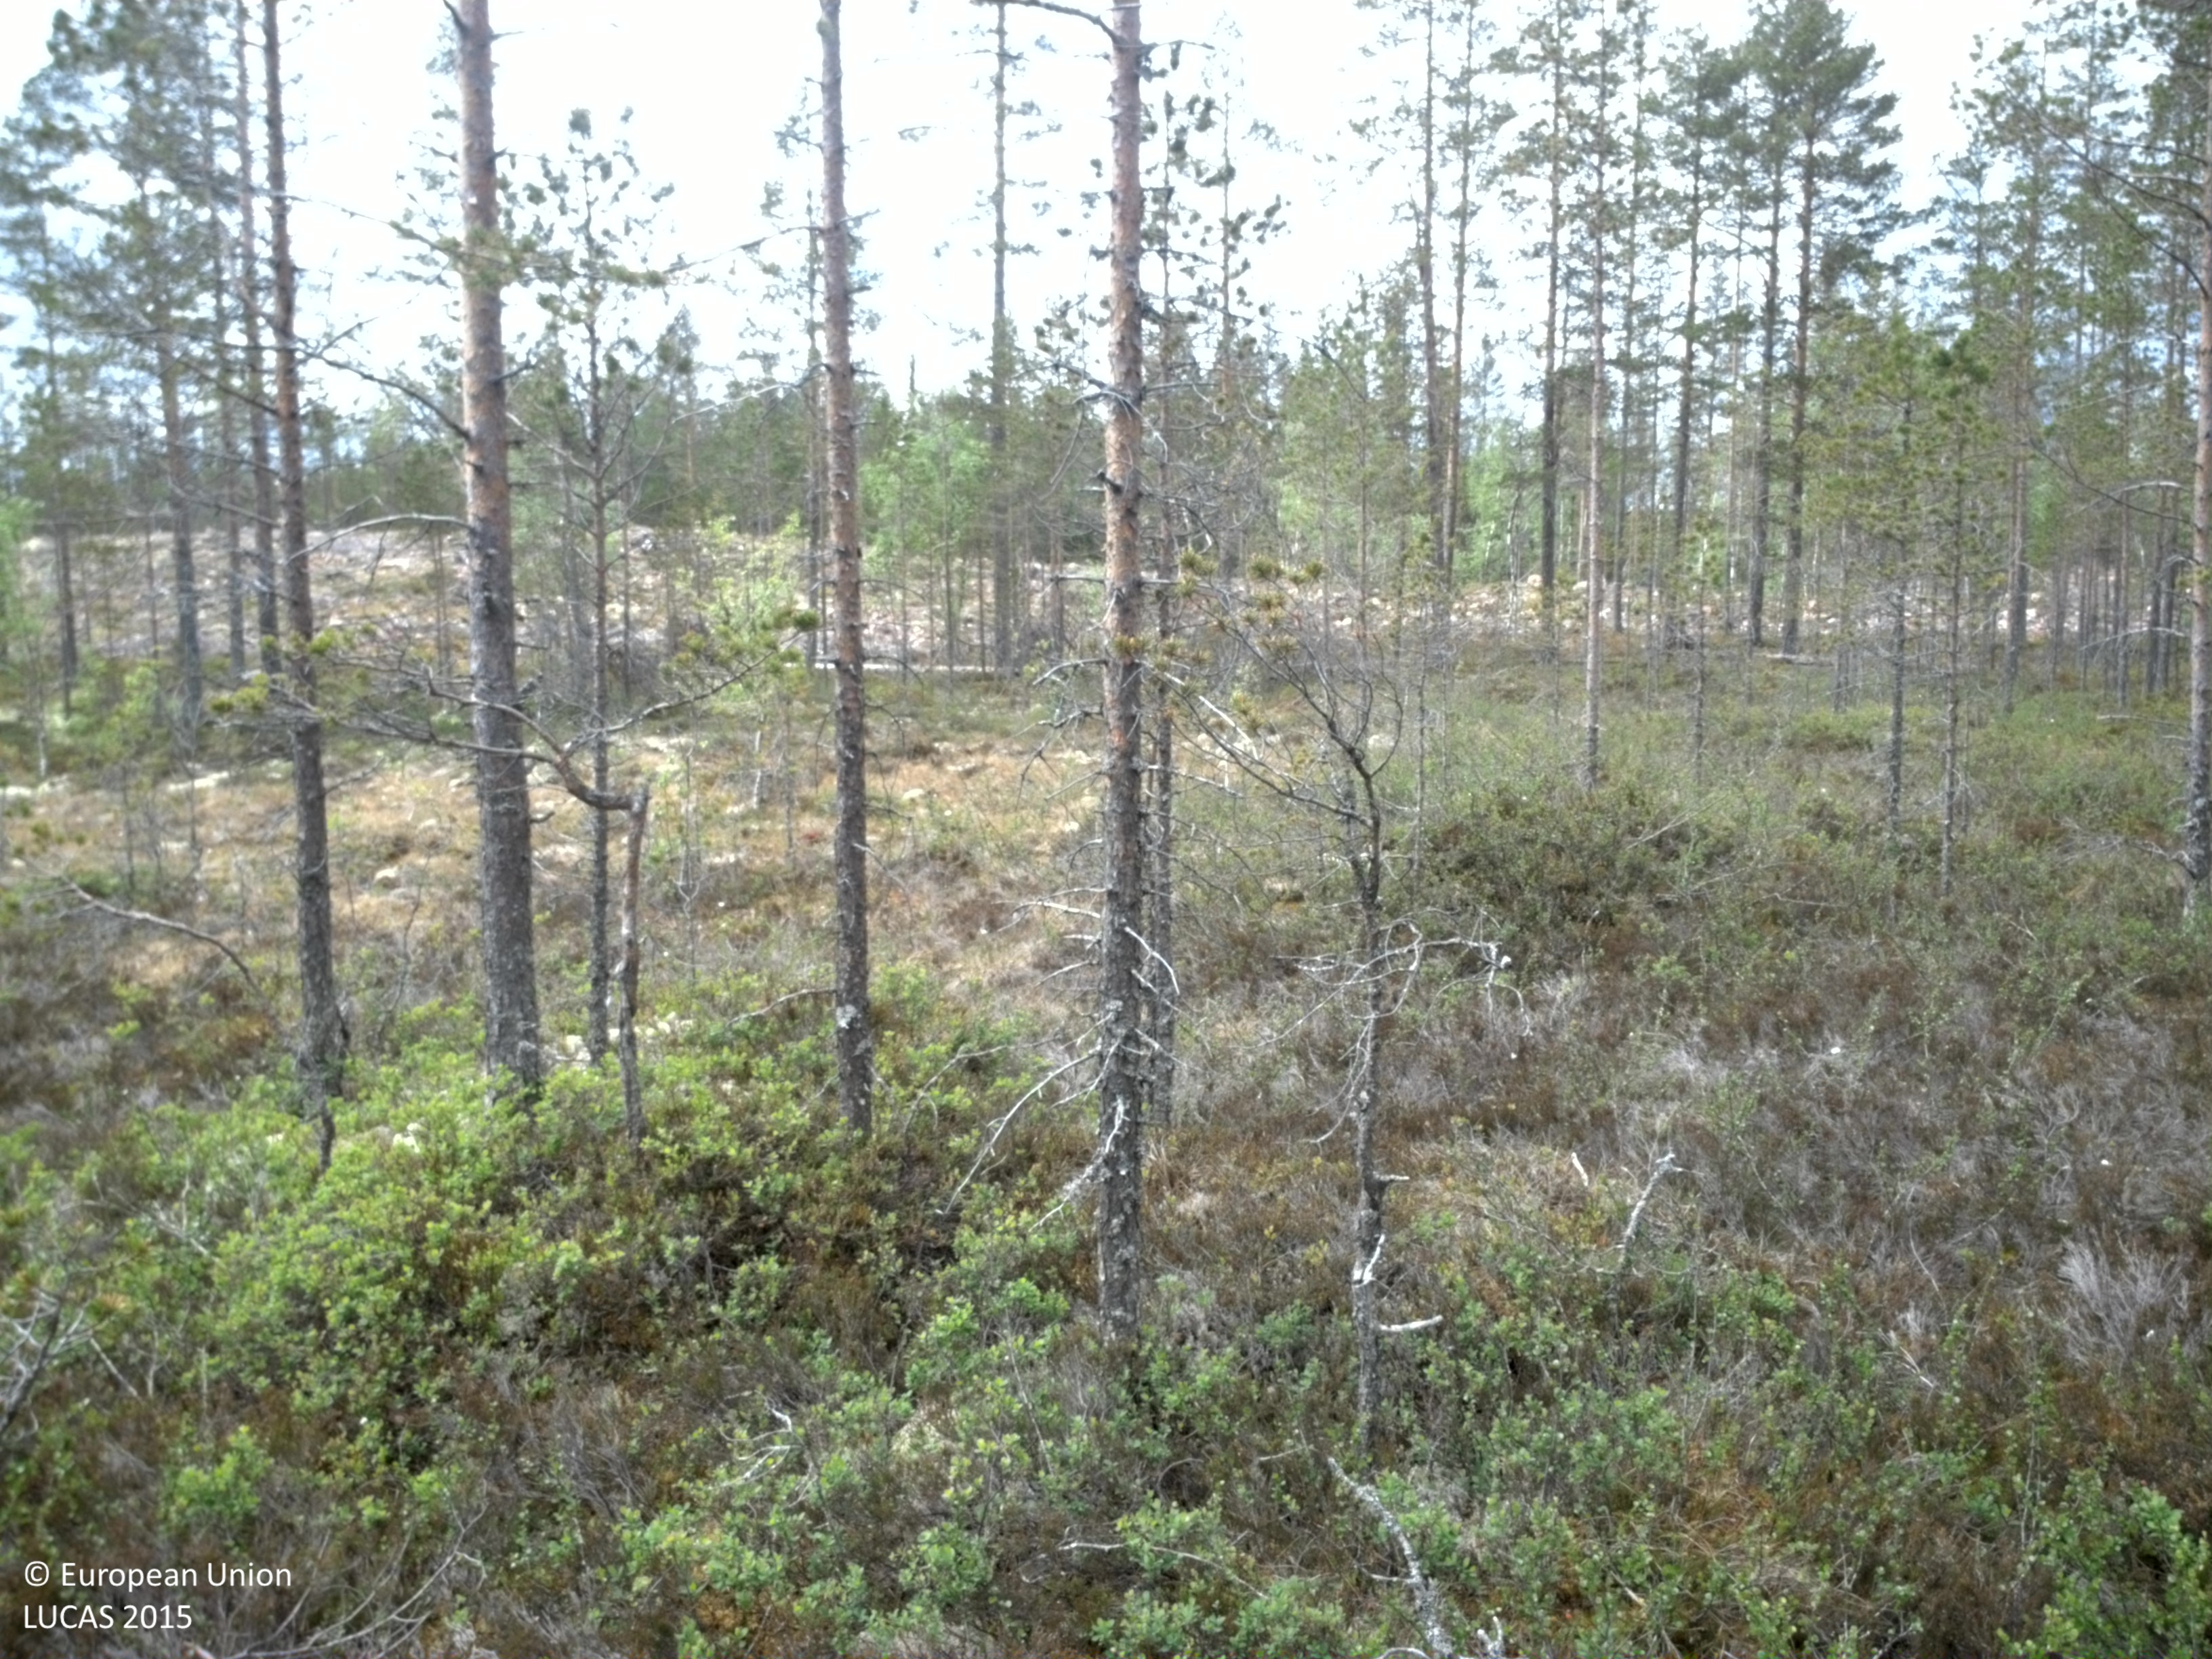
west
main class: Woodland
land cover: Pine dominated coniferous woodland
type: boreal forest
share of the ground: 50 - 75 %
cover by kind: coniferous forest trees 60 %, herbaceous plants 20 %, lichens and mosses 20 %
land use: Forestry
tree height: > 5 m
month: June
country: SE
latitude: 61.3067
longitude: 13.5911
